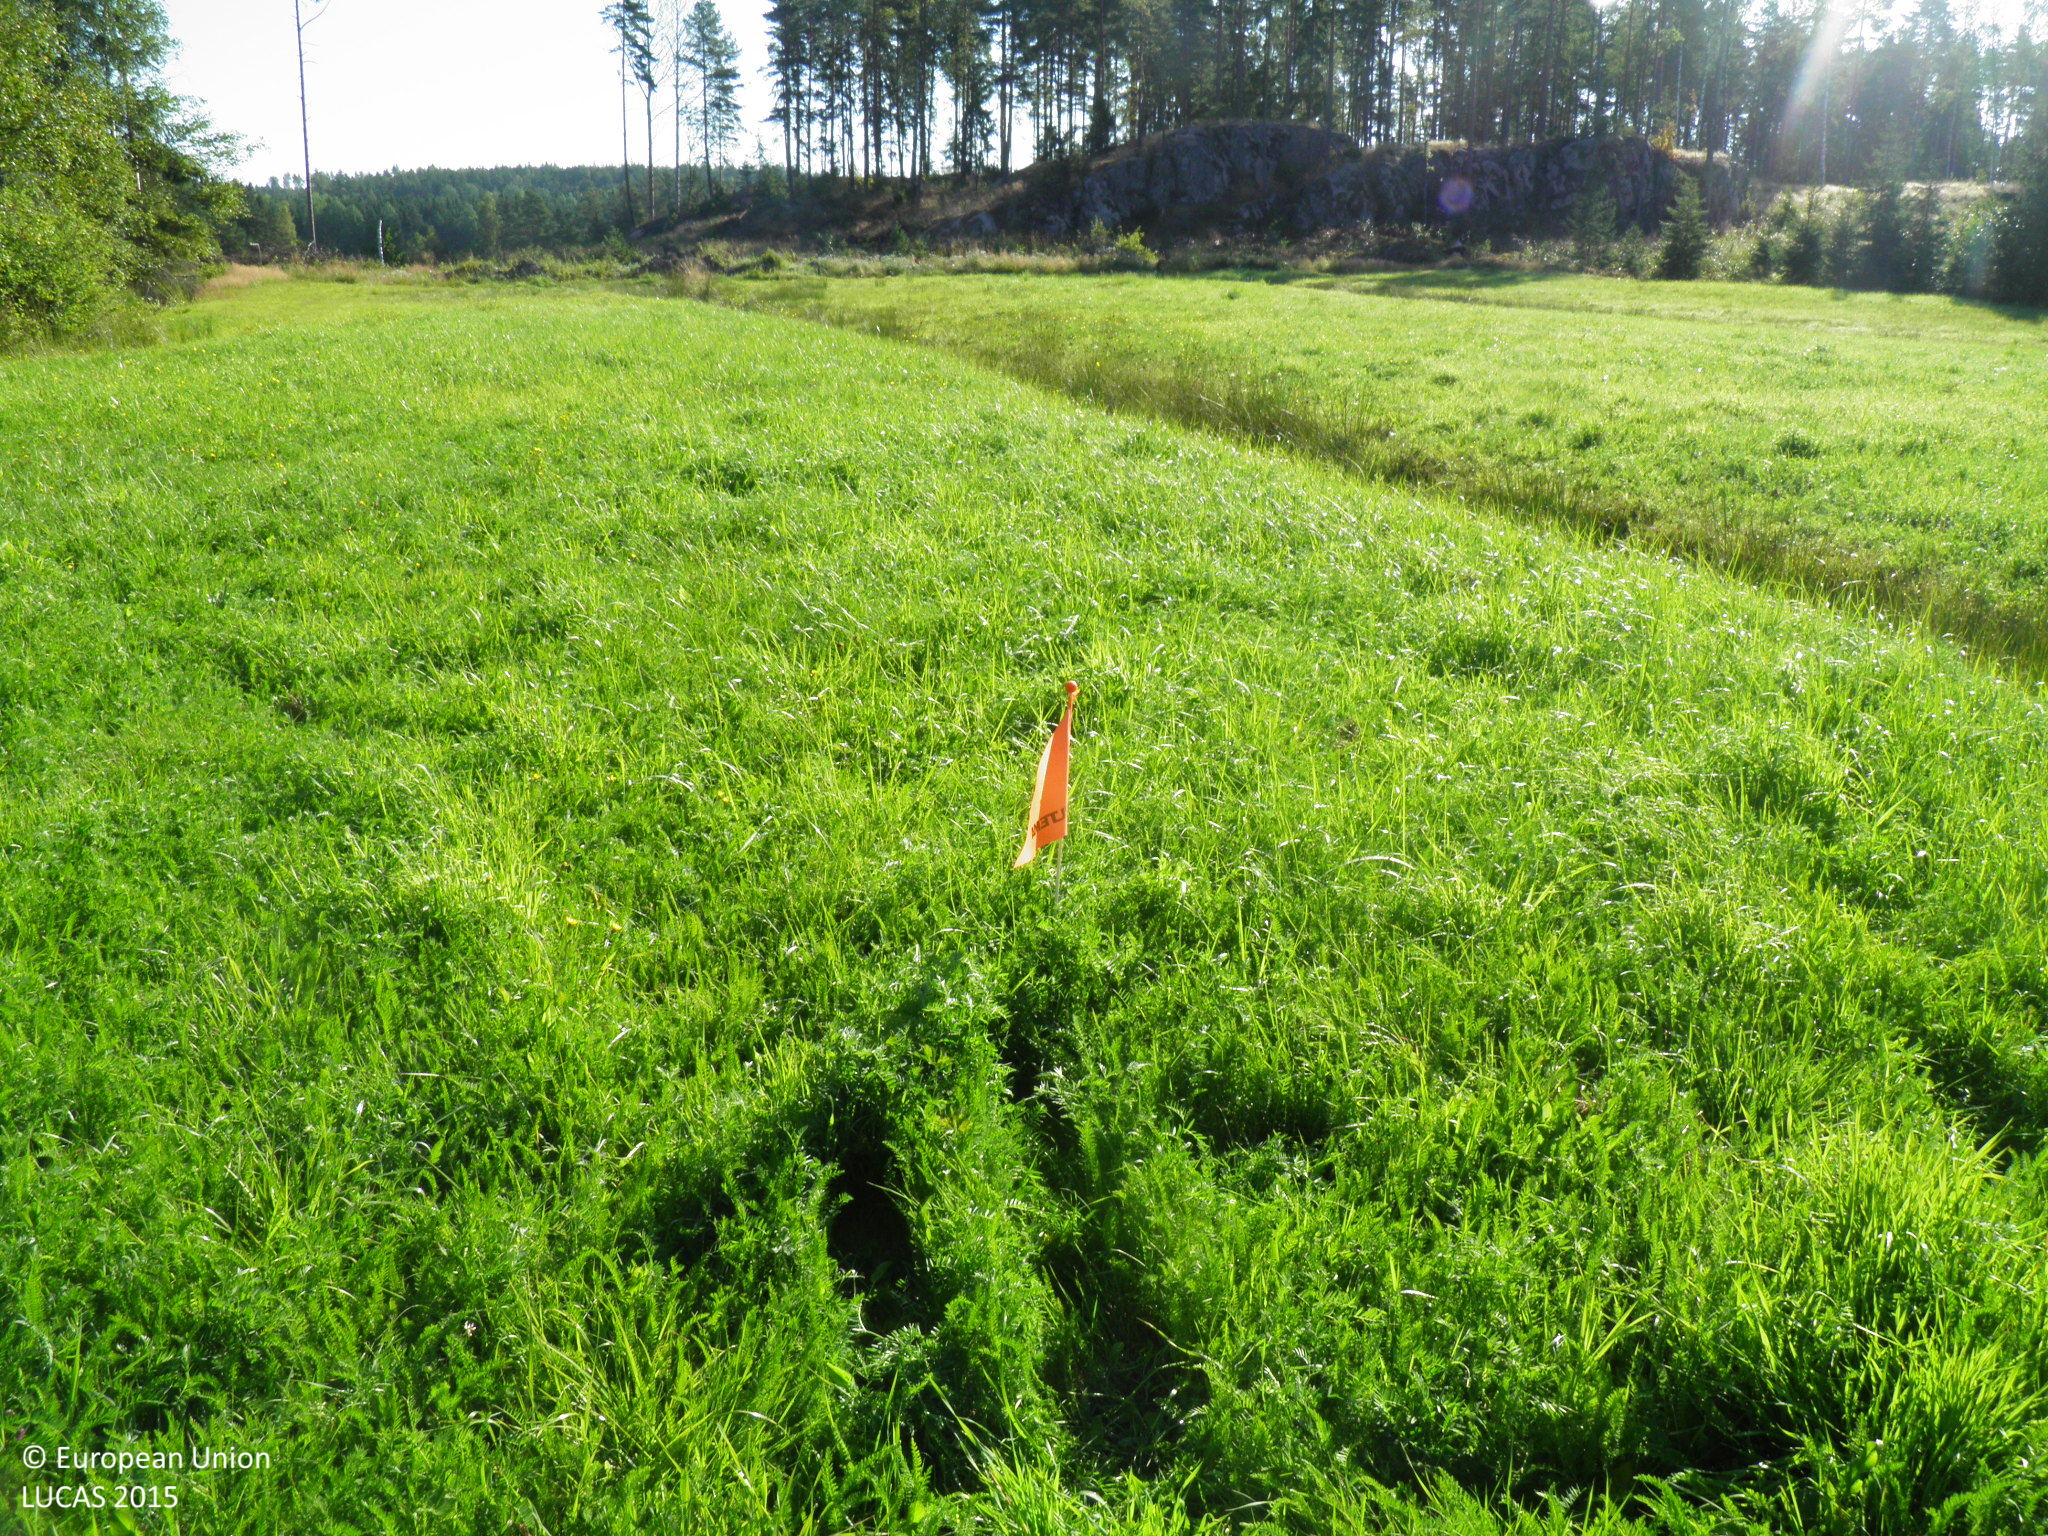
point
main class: Grassland
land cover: Grassland without tree/shrub cover
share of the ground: > 75 %
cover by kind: herbaceous plants 100 %
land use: Agriculture (excluding fallow land and kitchen gardens)
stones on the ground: < 10 %
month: August
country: FI
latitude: 60.1932
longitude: 22.6451
